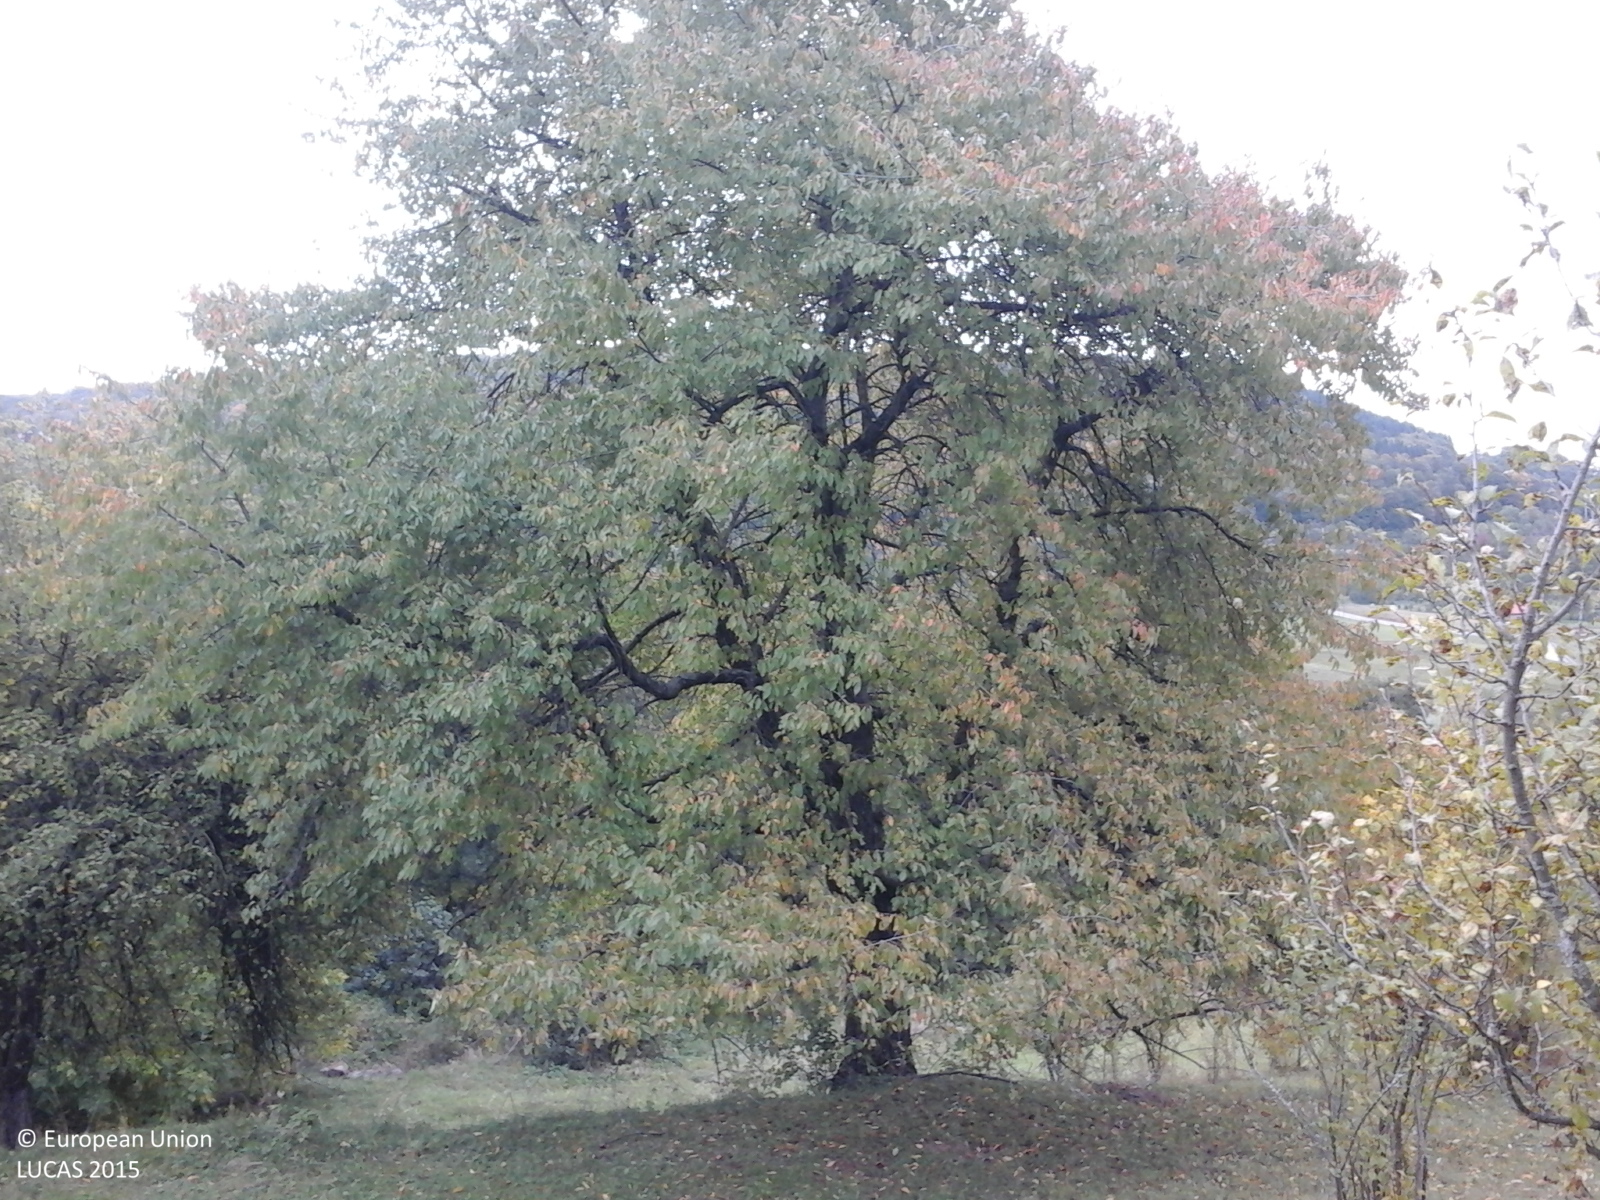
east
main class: Cropland
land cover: Apple fruit
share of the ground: > 75 %
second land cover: Grassland without tree/shrub cover
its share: > 75 %
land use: Agriculture (excluding fallow land and kitchen gardens)
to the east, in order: Apple fruit; Grassland without tree/shrub cover; Broadleaved woodland; Rivers and streams; Broadleaved woodland; Tracks; Grass margins; Fences; Grass margins; Lines of trees; Fences; Grassland without tree/shrub cover; Permanent crops (only in case pi); Abandoned hedges; Paved roads, cycling and walking lanes; Spontaneously vegetated surfaces; Fences; Grass margins; Other bare soil; Fences; Broadleaved woodland
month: October
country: RO
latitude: 46.4130
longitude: 25.3119
